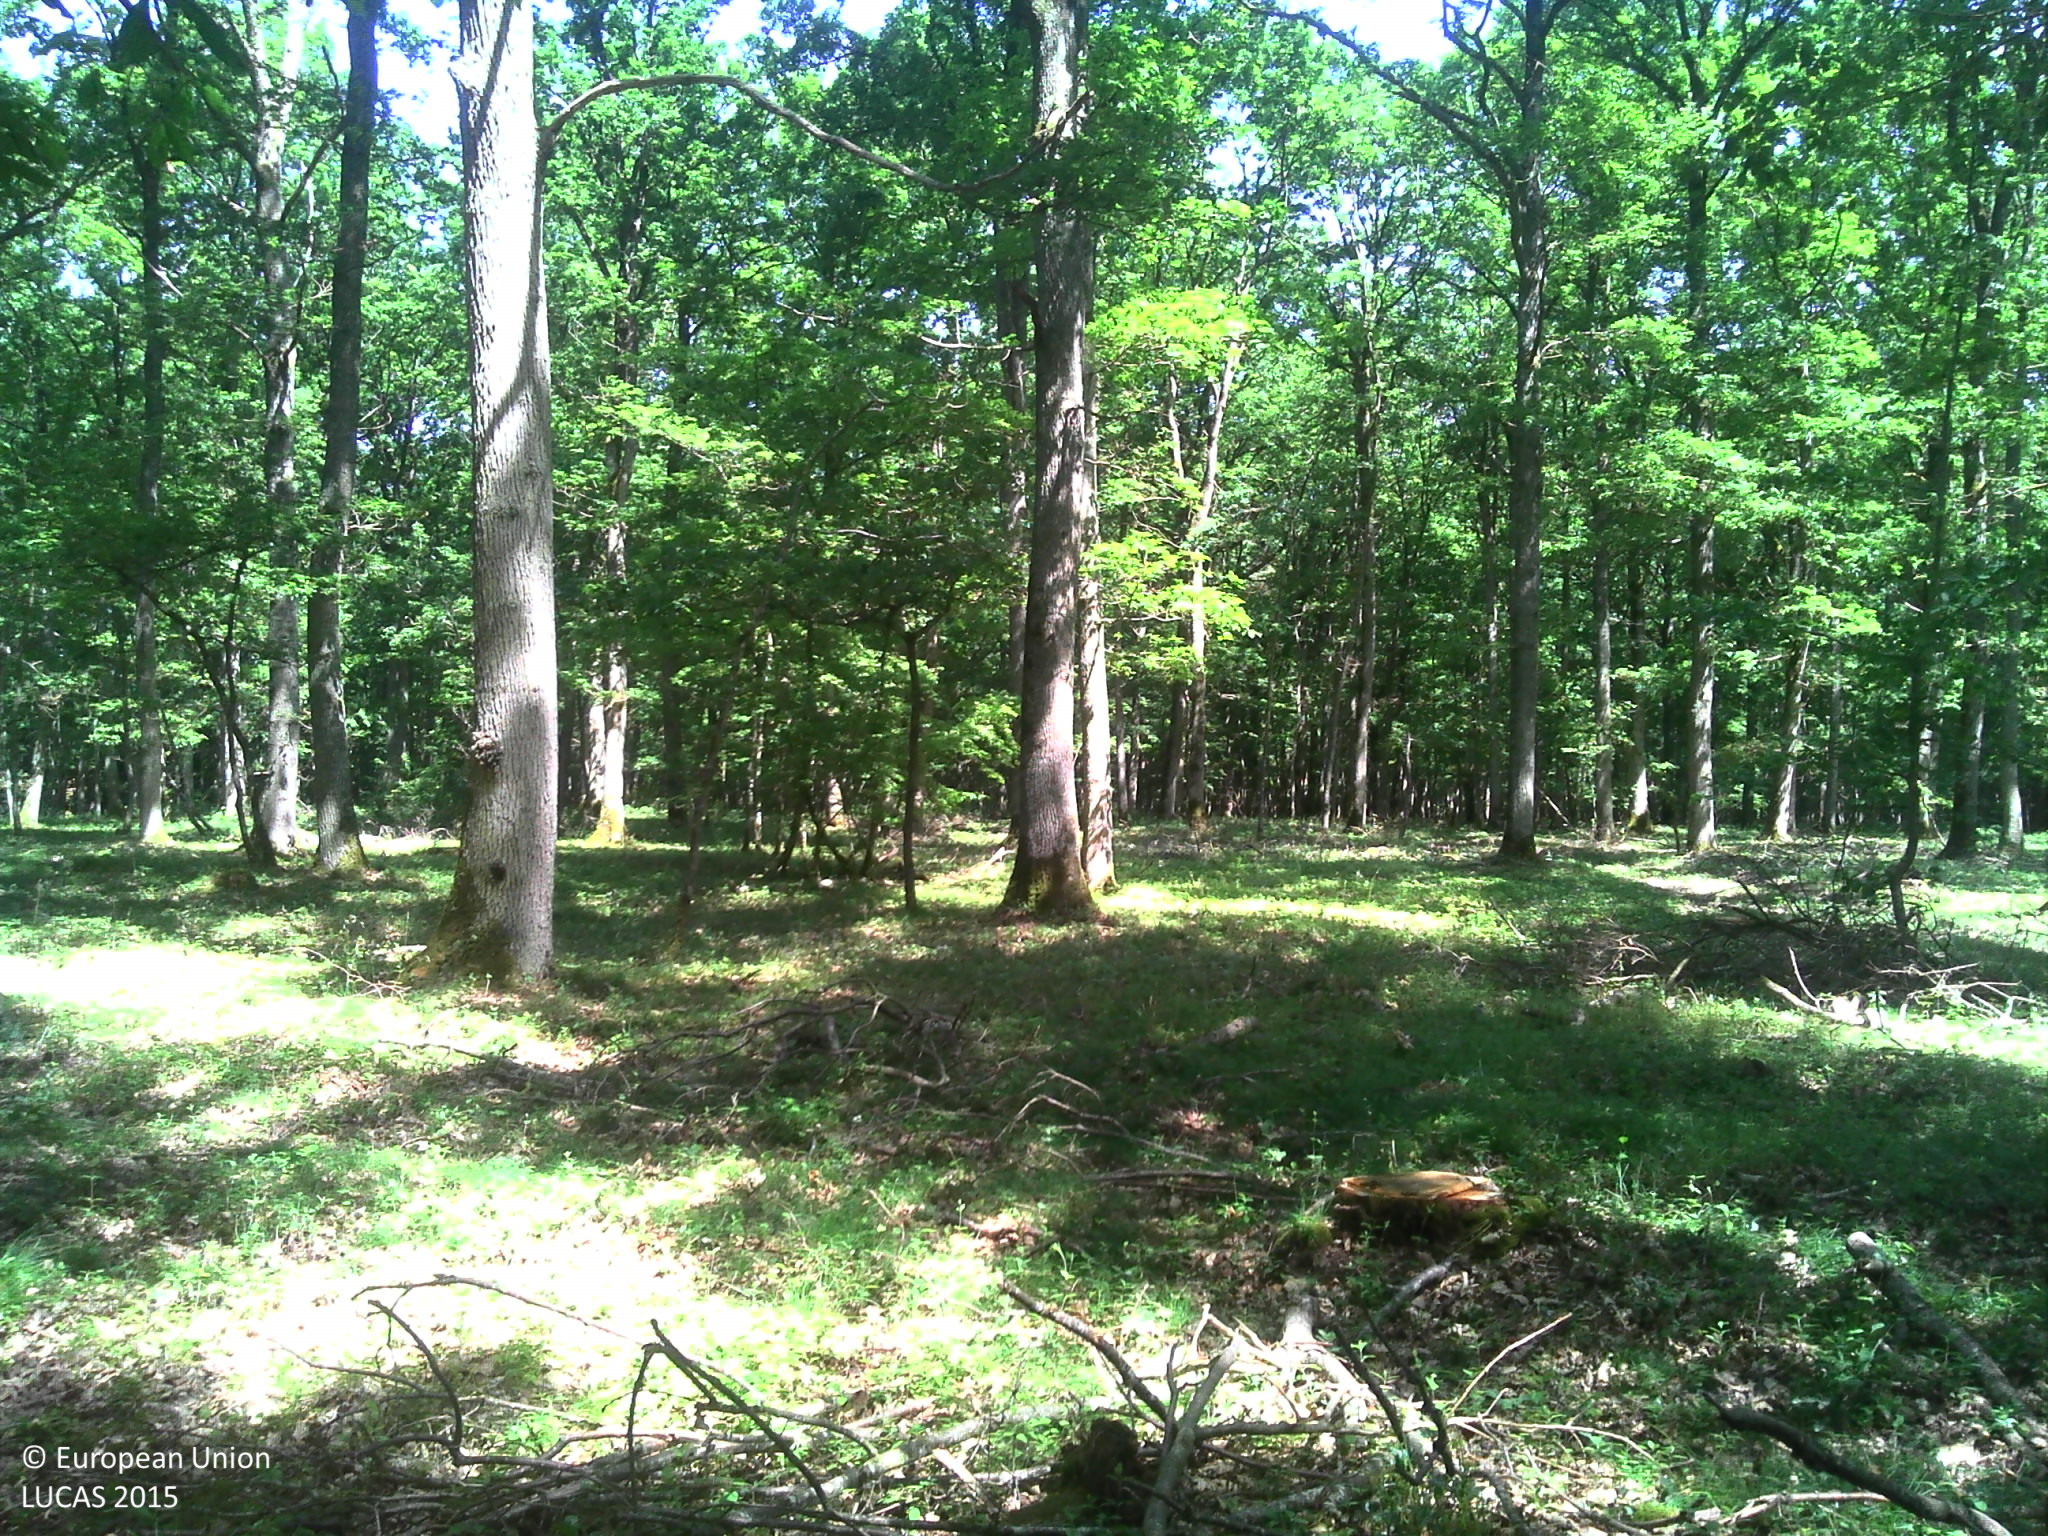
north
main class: Woodland
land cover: Broadleaved woodland
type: mesophytic deciduous forest
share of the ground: > 75 %
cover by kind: broadleaved forest trees 80 %, herbaceous plants 10 %, lichens and mosses 10 %
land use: Forestry
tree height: > 5 m
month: June
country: FR
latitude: 48.6156
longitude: 1.2318
